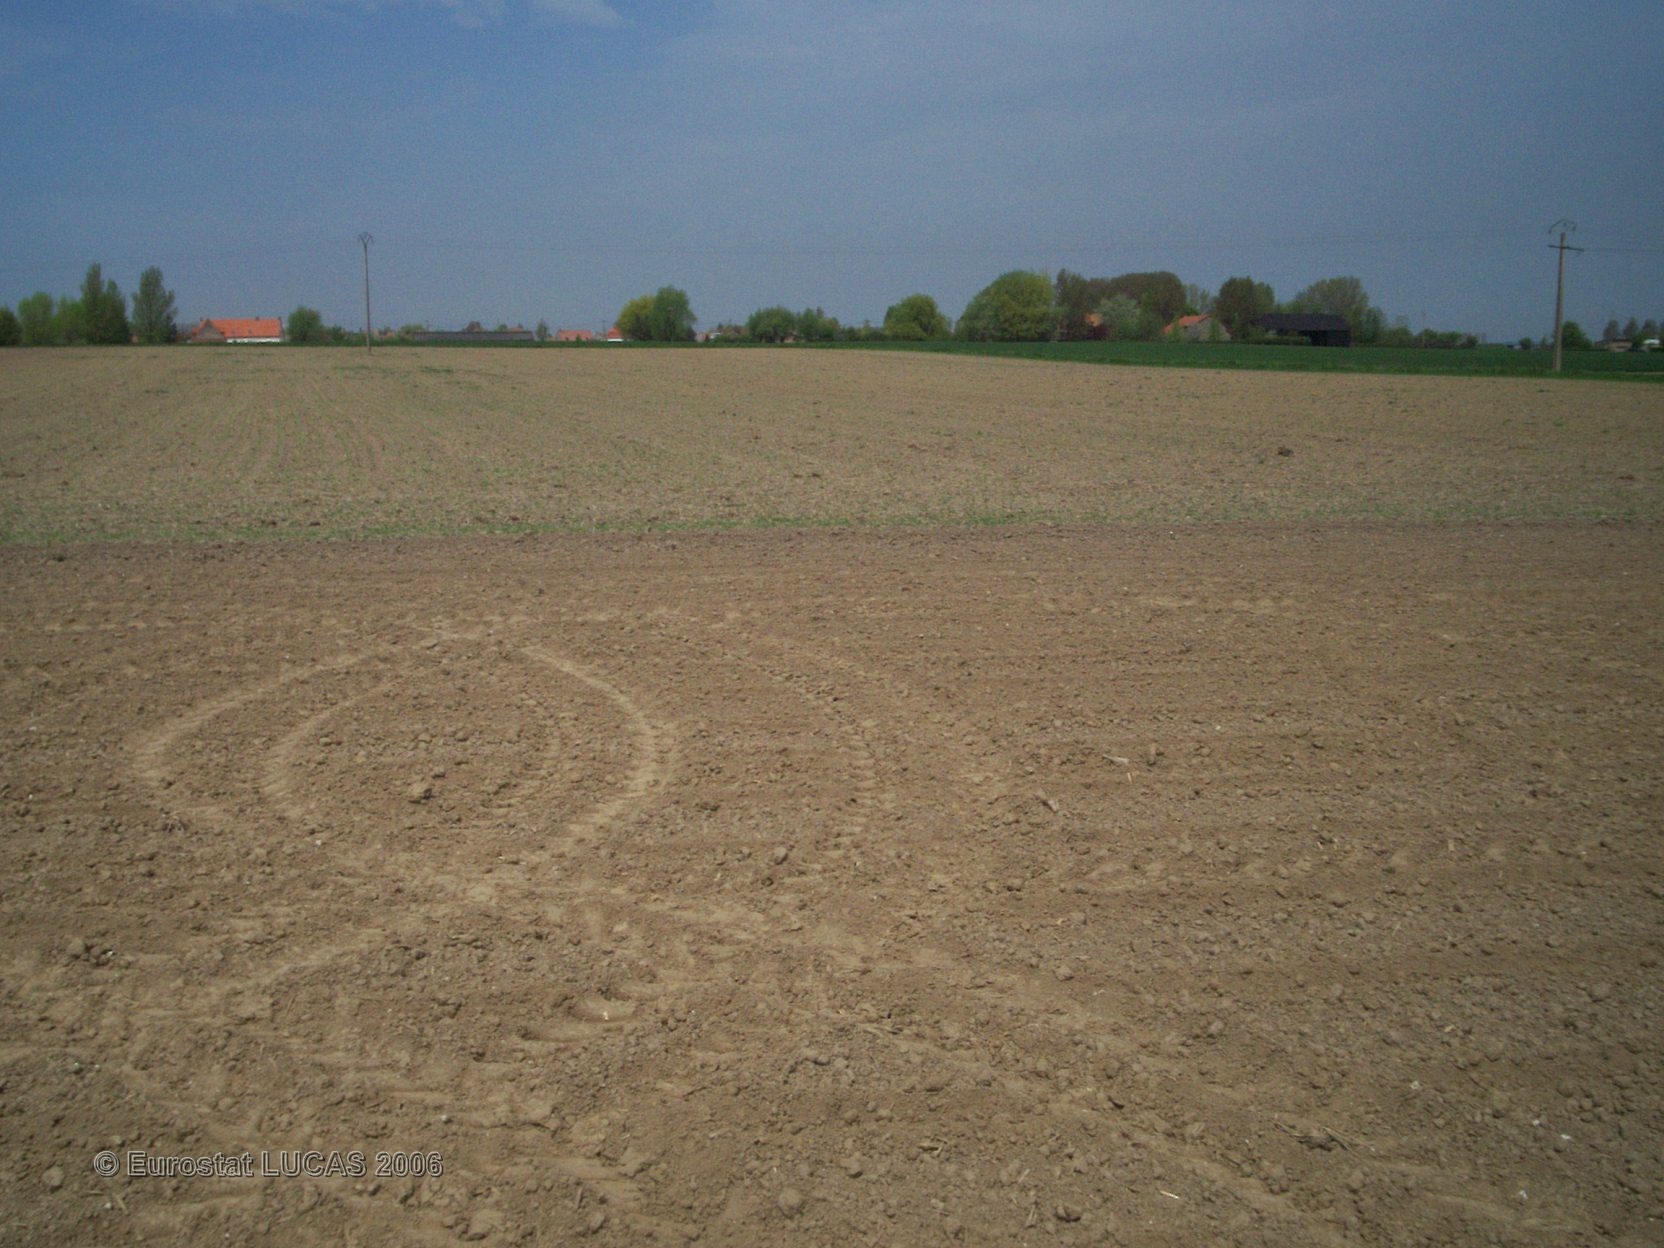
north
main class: Cropland
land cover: Maize
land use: Agriculture (excluding fallow land and kitchen gardens)
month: May
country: FR
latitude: 50.9277
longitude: 2.4606
